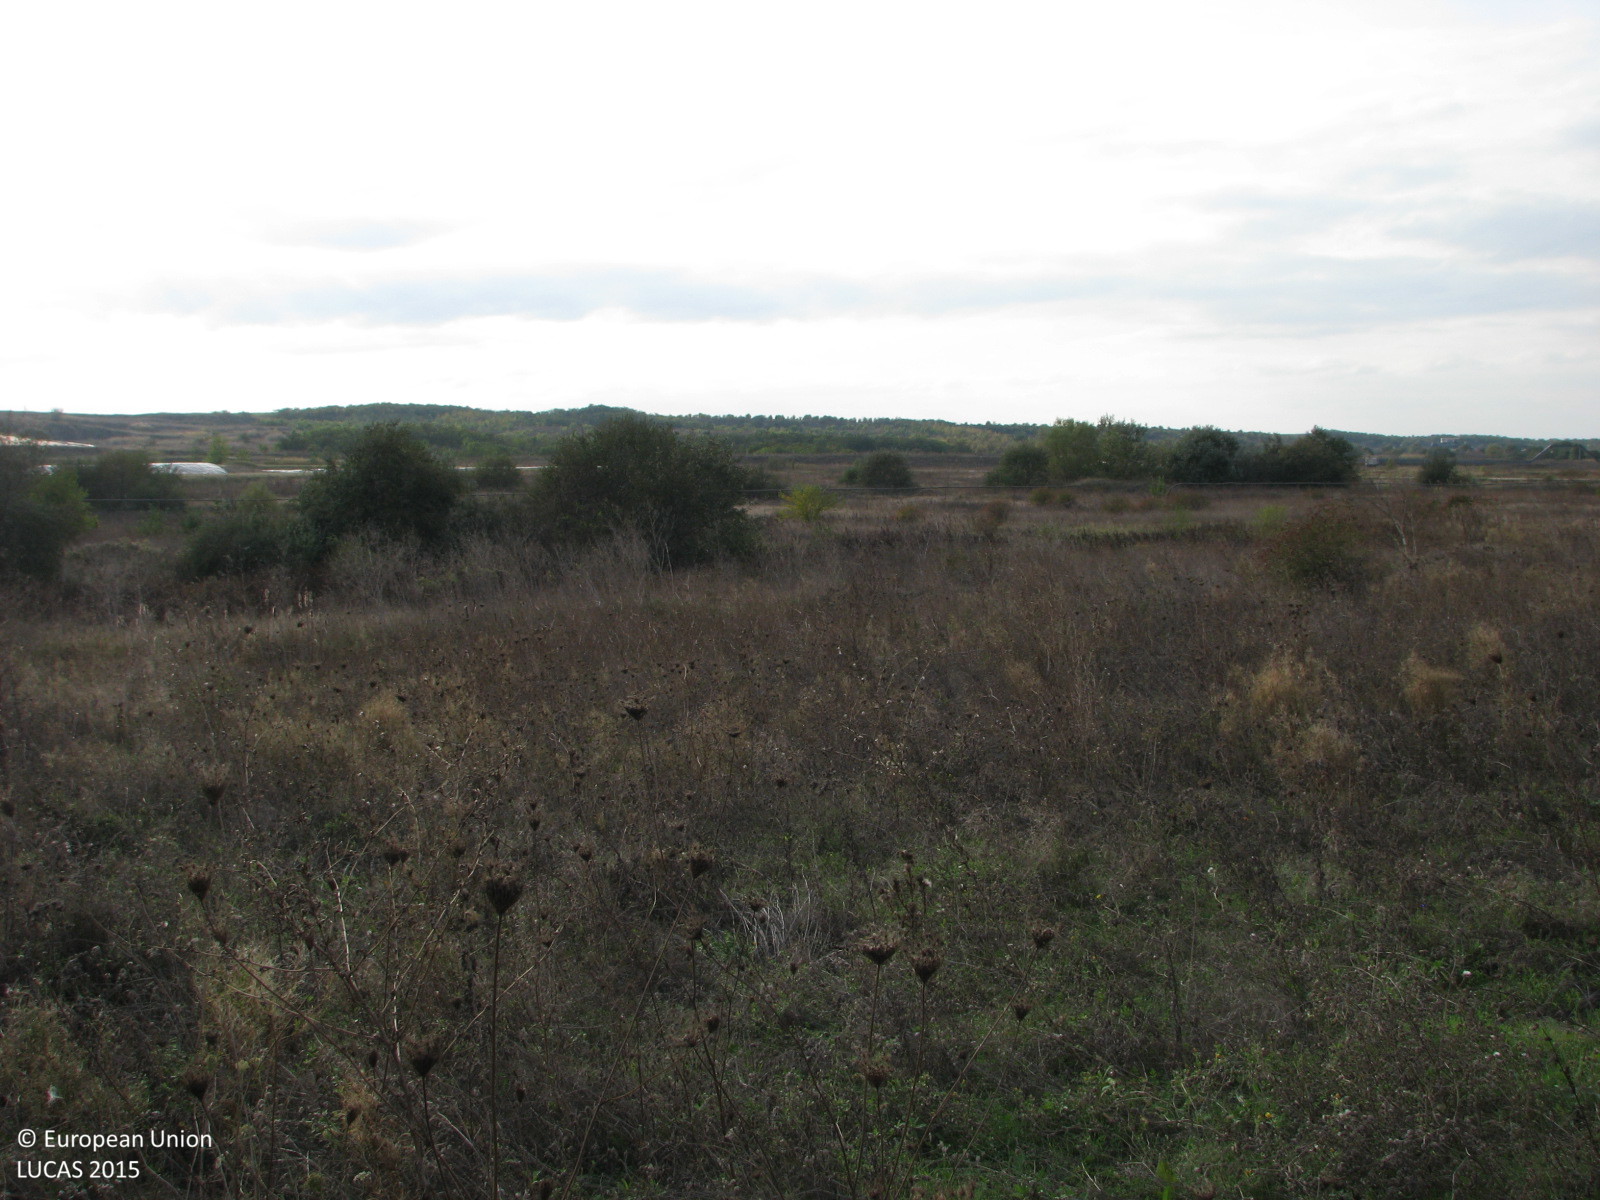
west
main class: Grassland
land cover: Grassland without tree/shrub cover
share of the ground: > 75 %
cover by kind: herbaceous plants 95 %, shrubs 5 %
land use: Agriculture (excluding fallow land and kitchen gardens)
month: October
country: BG
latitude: 42.2326
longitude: 26.1355
